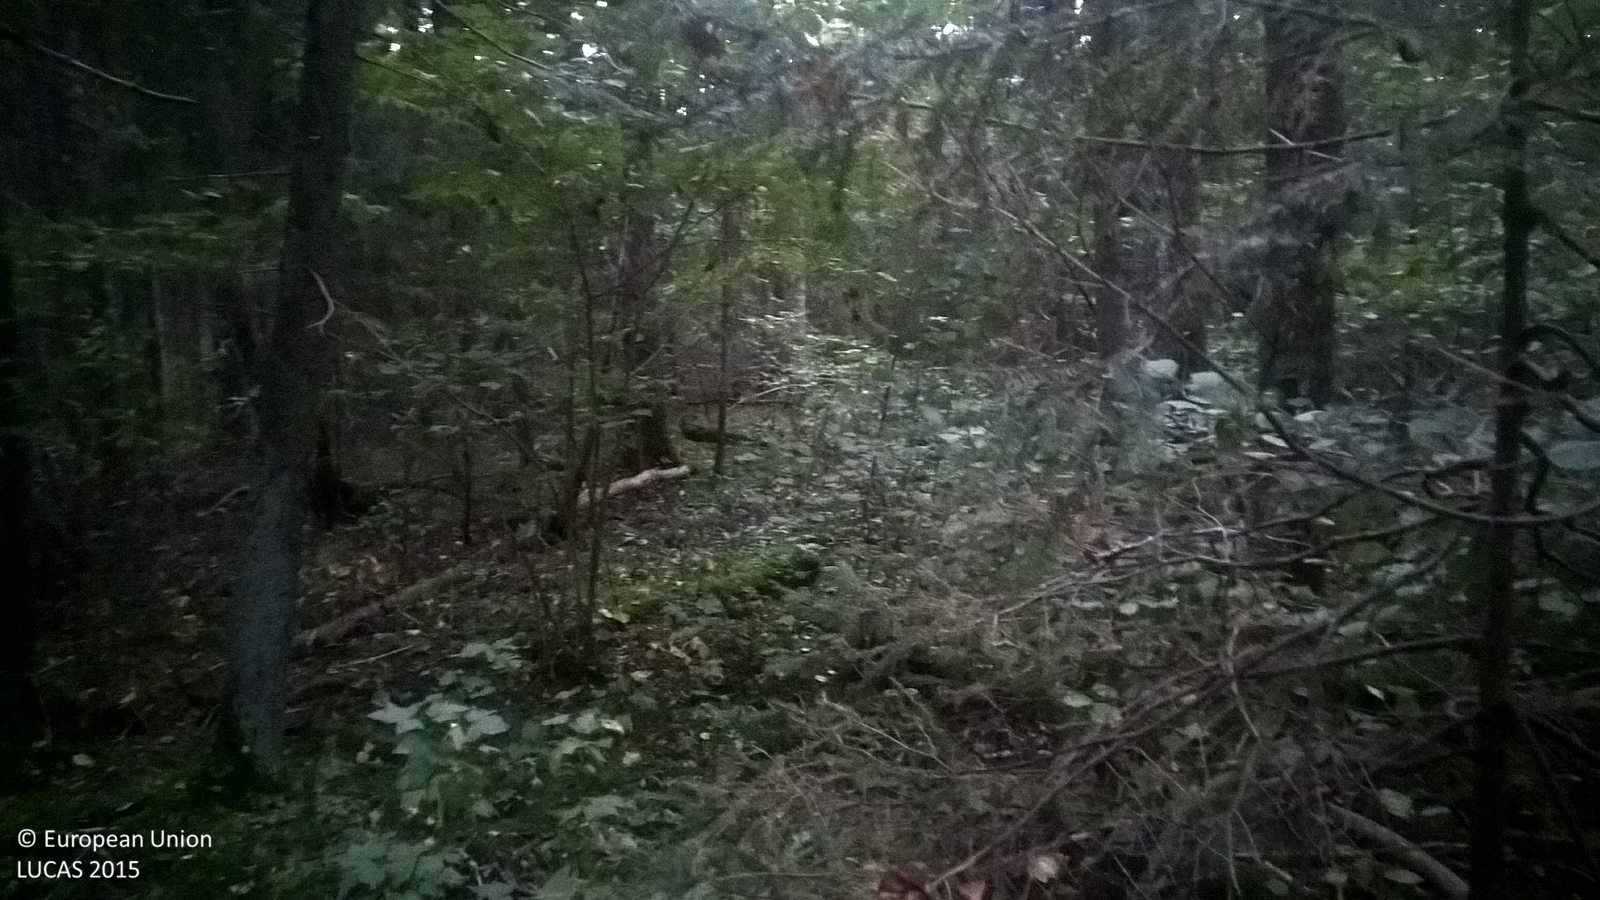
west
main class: Woodland
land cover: Other mixed woodland
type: hemiboreal forest and nemoral coniferous forest and mixed broadleaved-coniferous forest
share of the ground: > 75 %
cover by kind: broadleaved forest trees 45 %, coniferous forest trees 40 %, lichens and mosses 10 %, herbaceous plants 5 %
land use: Forestry
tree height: > 5 m
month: September
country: LV
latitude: 57.6065
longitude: 25.4947
